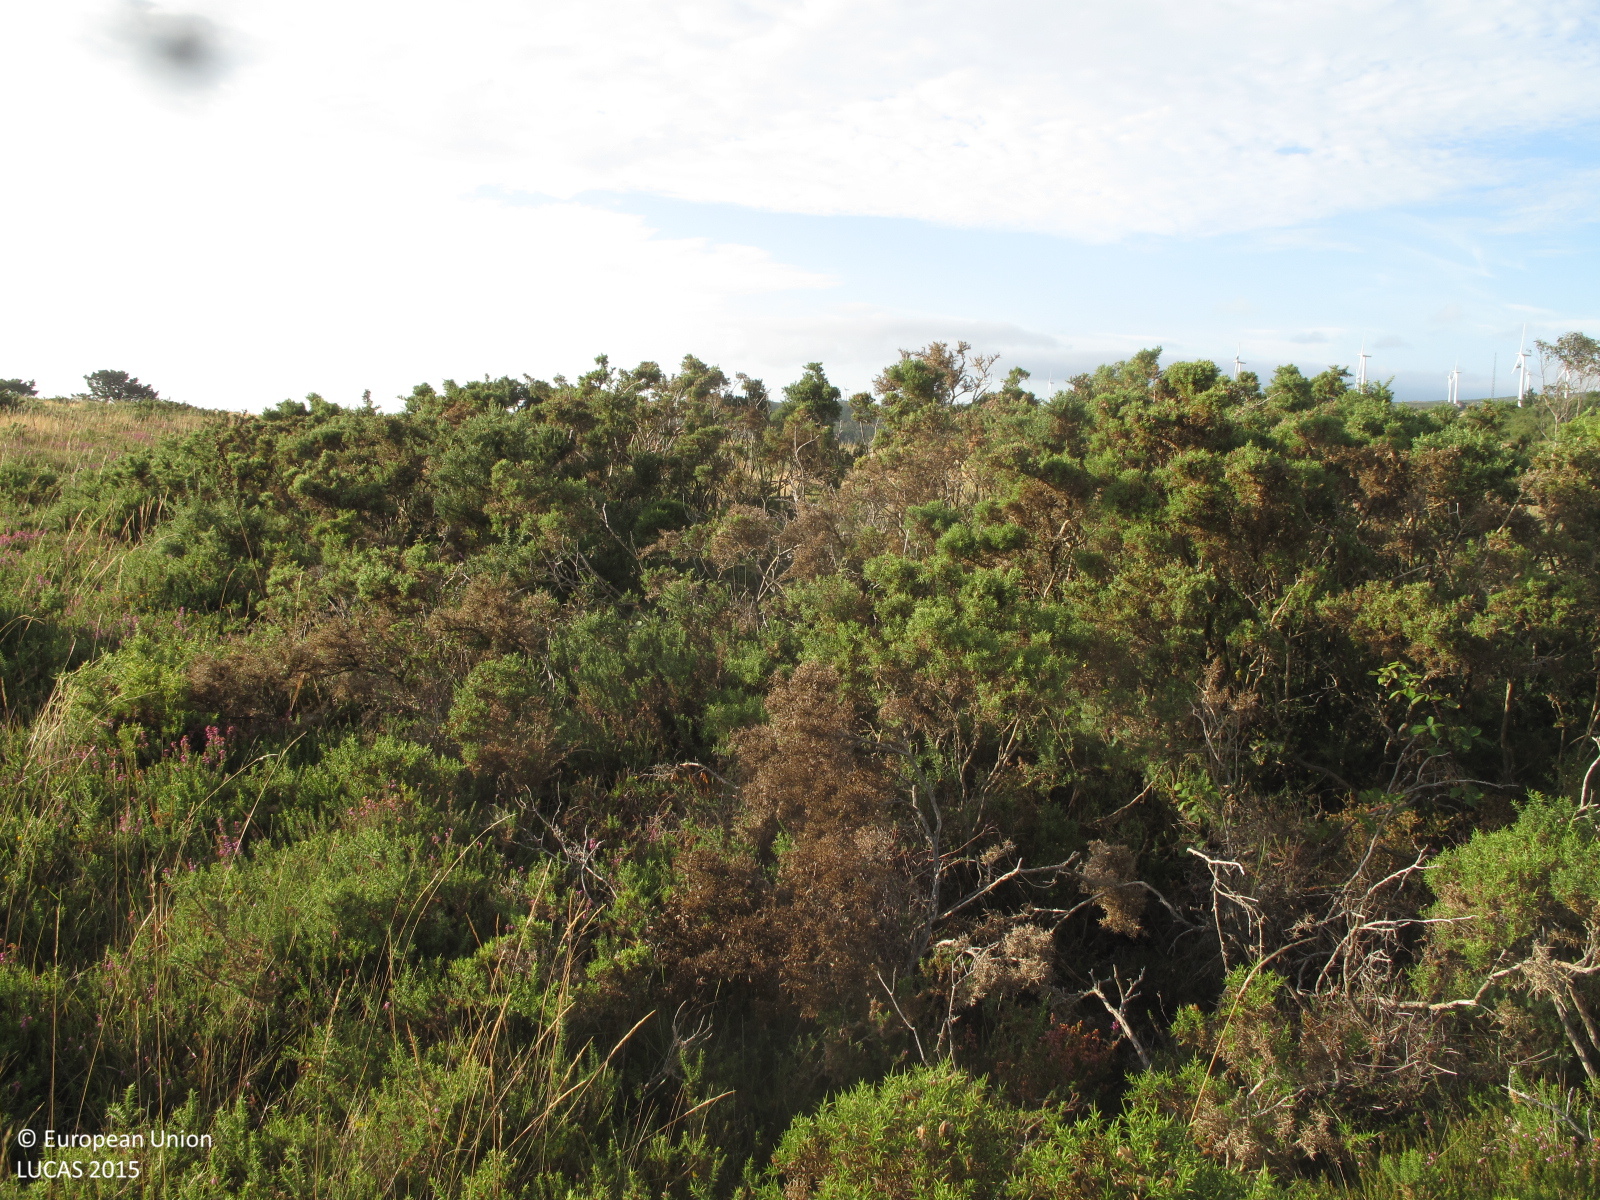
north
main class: Shrubland
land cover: Shrubland without tree cover
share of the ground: > 75 %
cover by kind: shrubs 80 %, herbaceous plants 20 %
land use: Abandoned areas
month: July
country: ES
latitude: 42.9822
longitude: -9.0952
